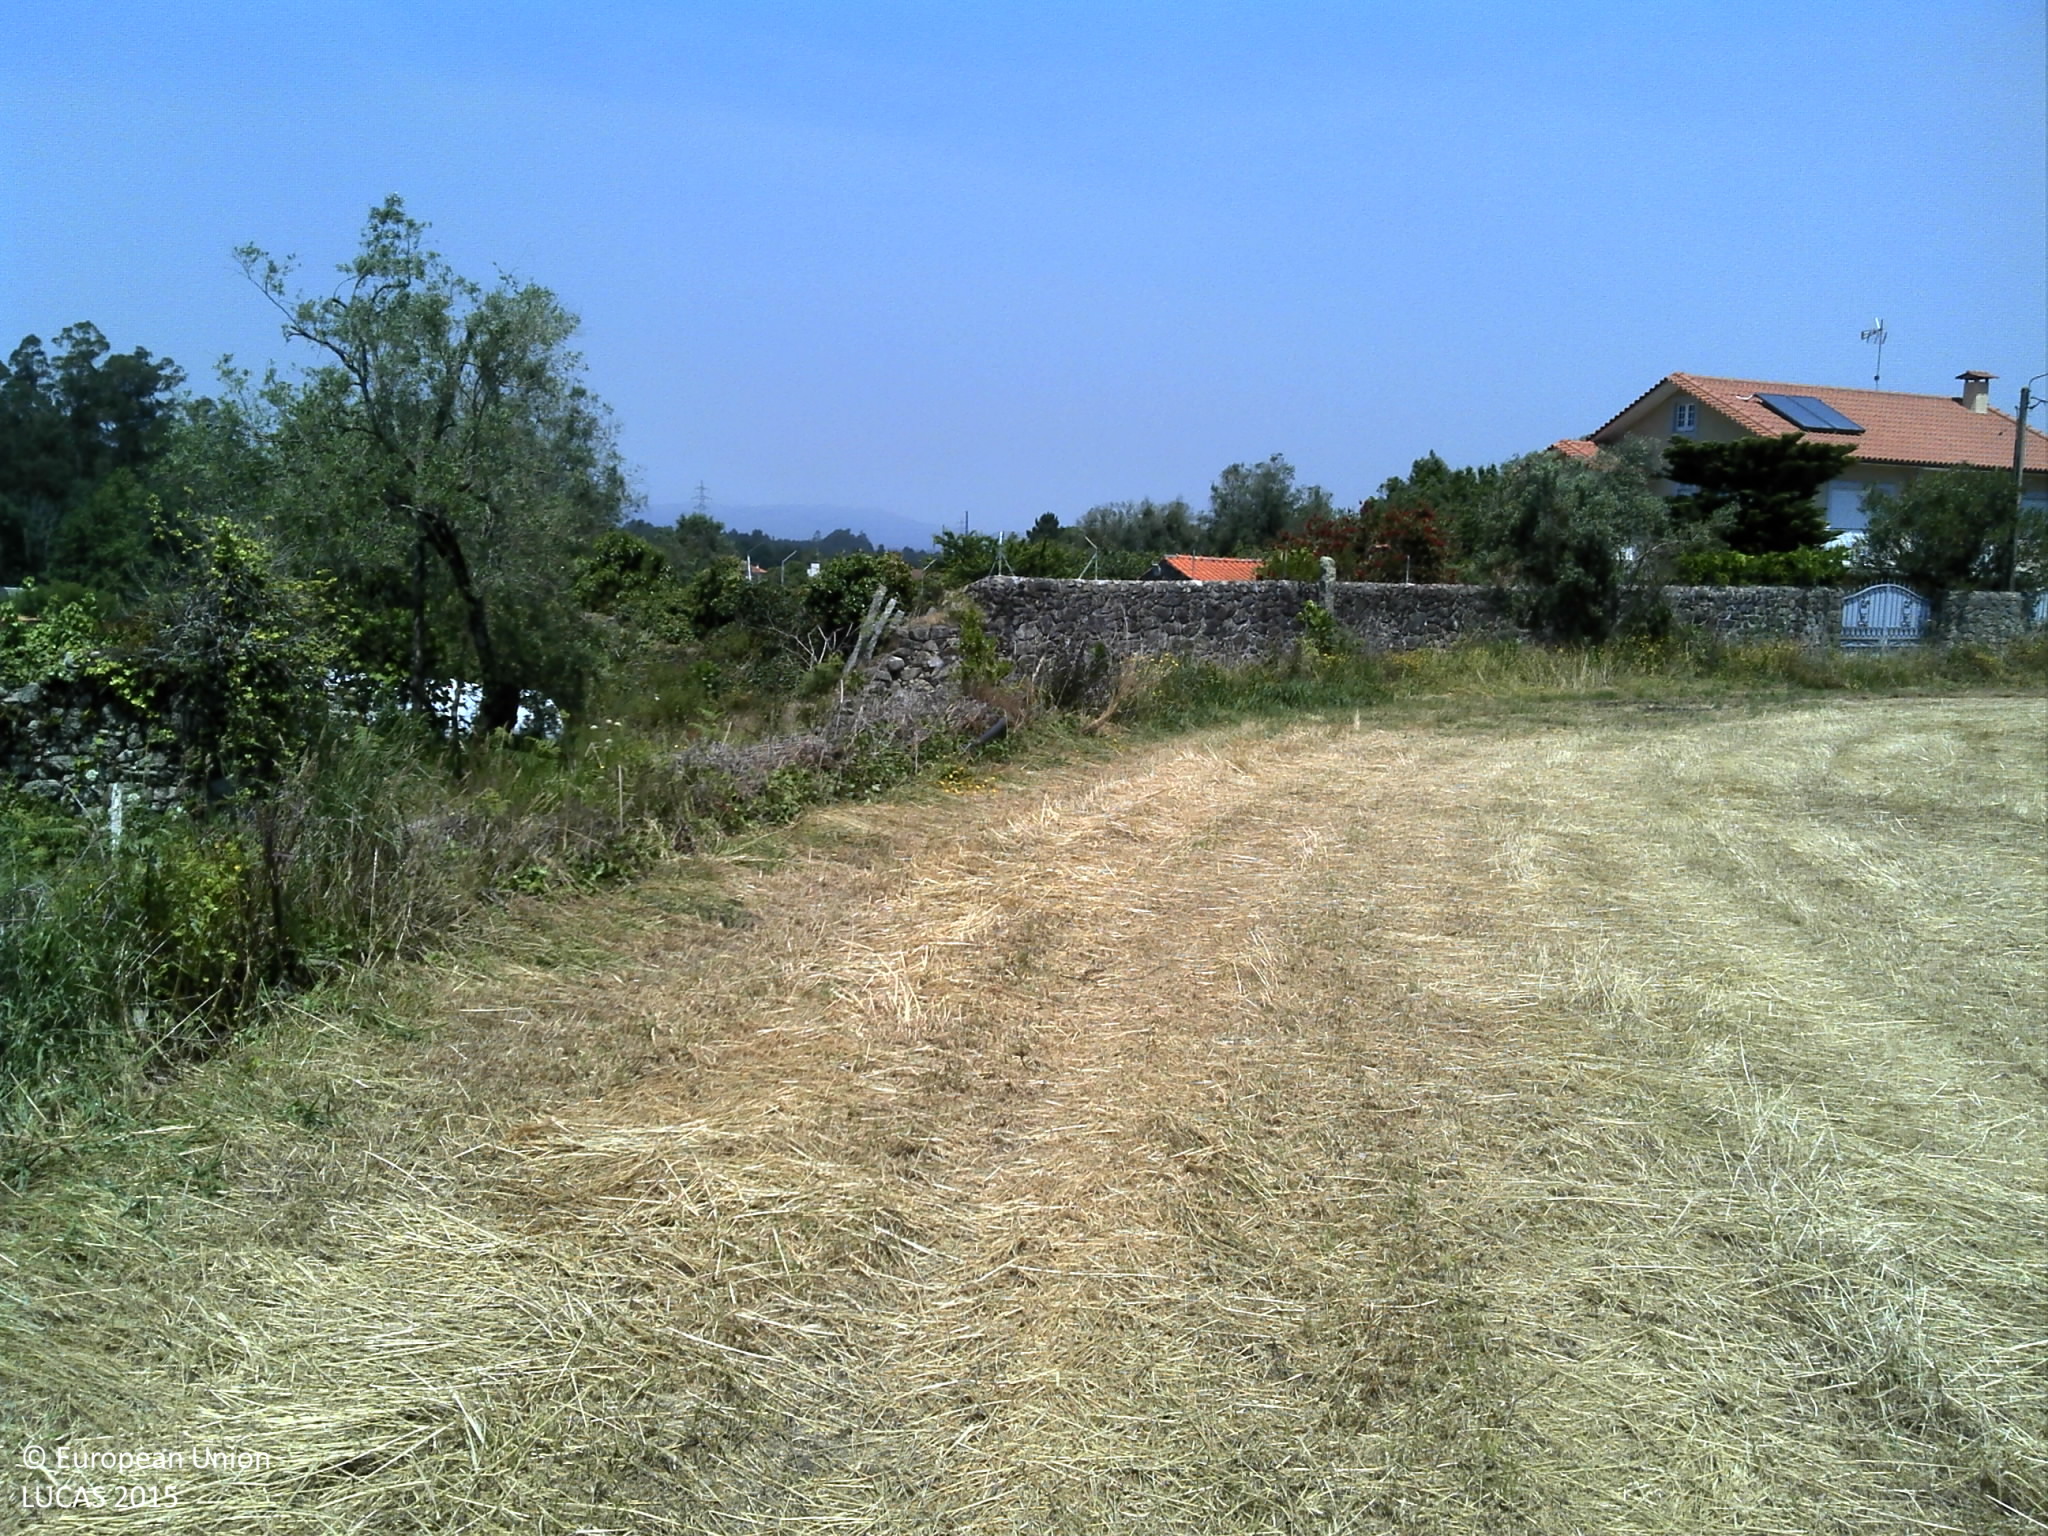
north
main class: Cropland
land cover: Temporary grasslands
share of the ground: 10 - 25 %
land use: Agriculture (excluding fallow land and kitchen gardens)
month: May
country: PT
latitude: 41.6053
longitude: -8.7510
